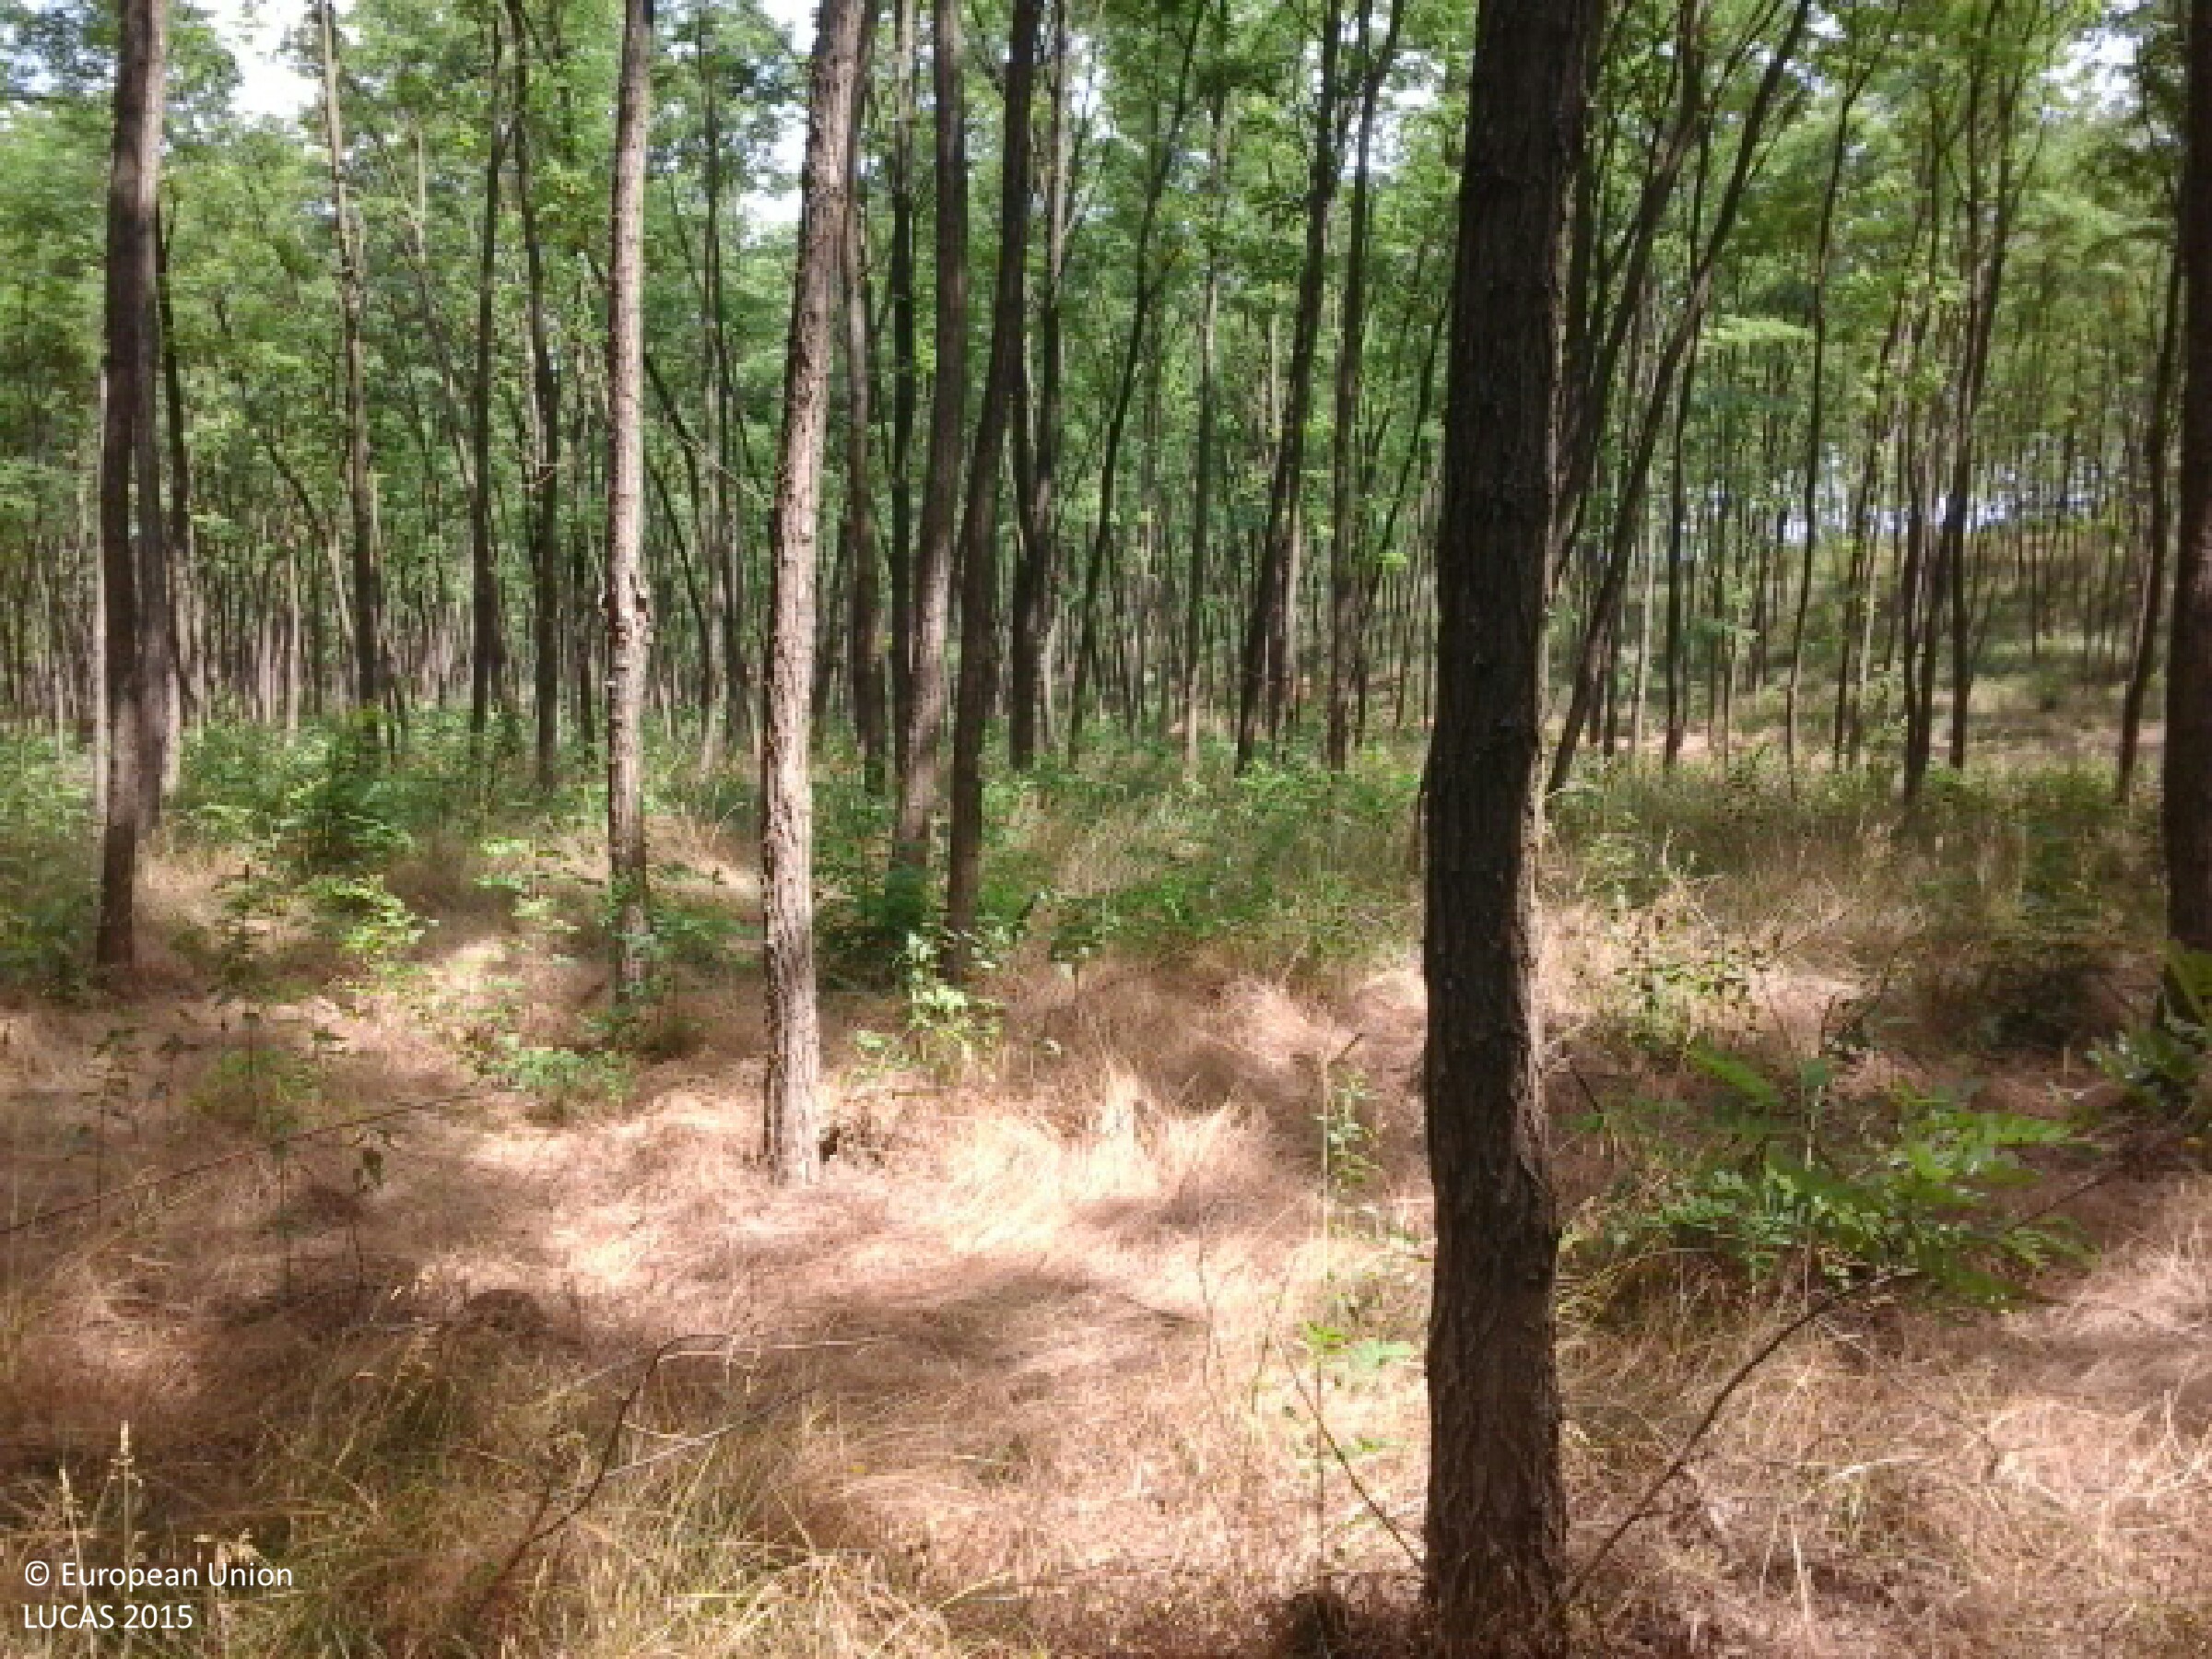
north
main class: Woodland
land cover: Broadleaved woodland
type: mesophytic deciduous forest
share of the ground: > 75 %
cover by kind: broadleaved forest trees 95 %, herbaceous plants 5 %
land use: Forestry
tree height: > 5 m
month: June
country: HU
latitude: 48.0794
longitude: 22.1216
